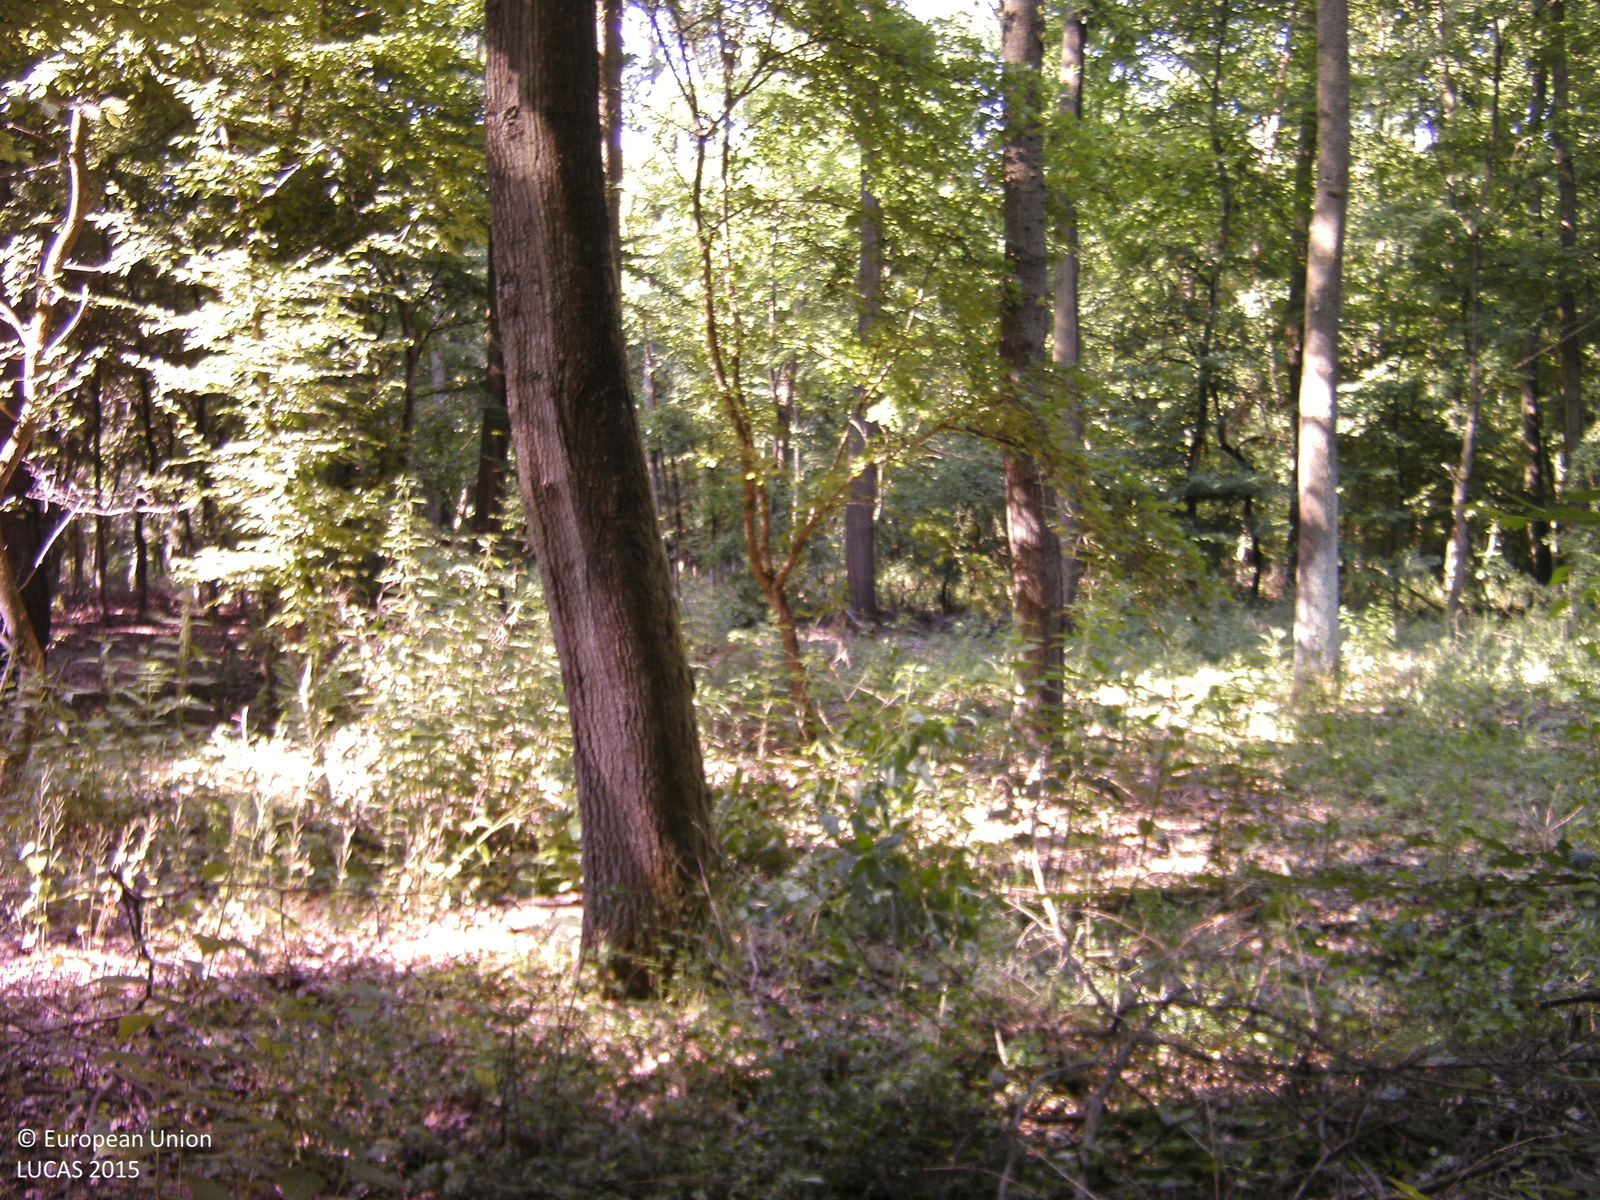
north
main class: Woodland
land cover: Broadleaved woodland
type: mesophytic deciduous forest
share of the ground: > 75 %
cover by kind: broadleaved forest trees 90 %, shrubs 5 %, herbaceous plants 5 %
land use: Forestry
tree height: > 5 m
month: June
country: HU
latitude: 46.4420
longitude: 17.8554
